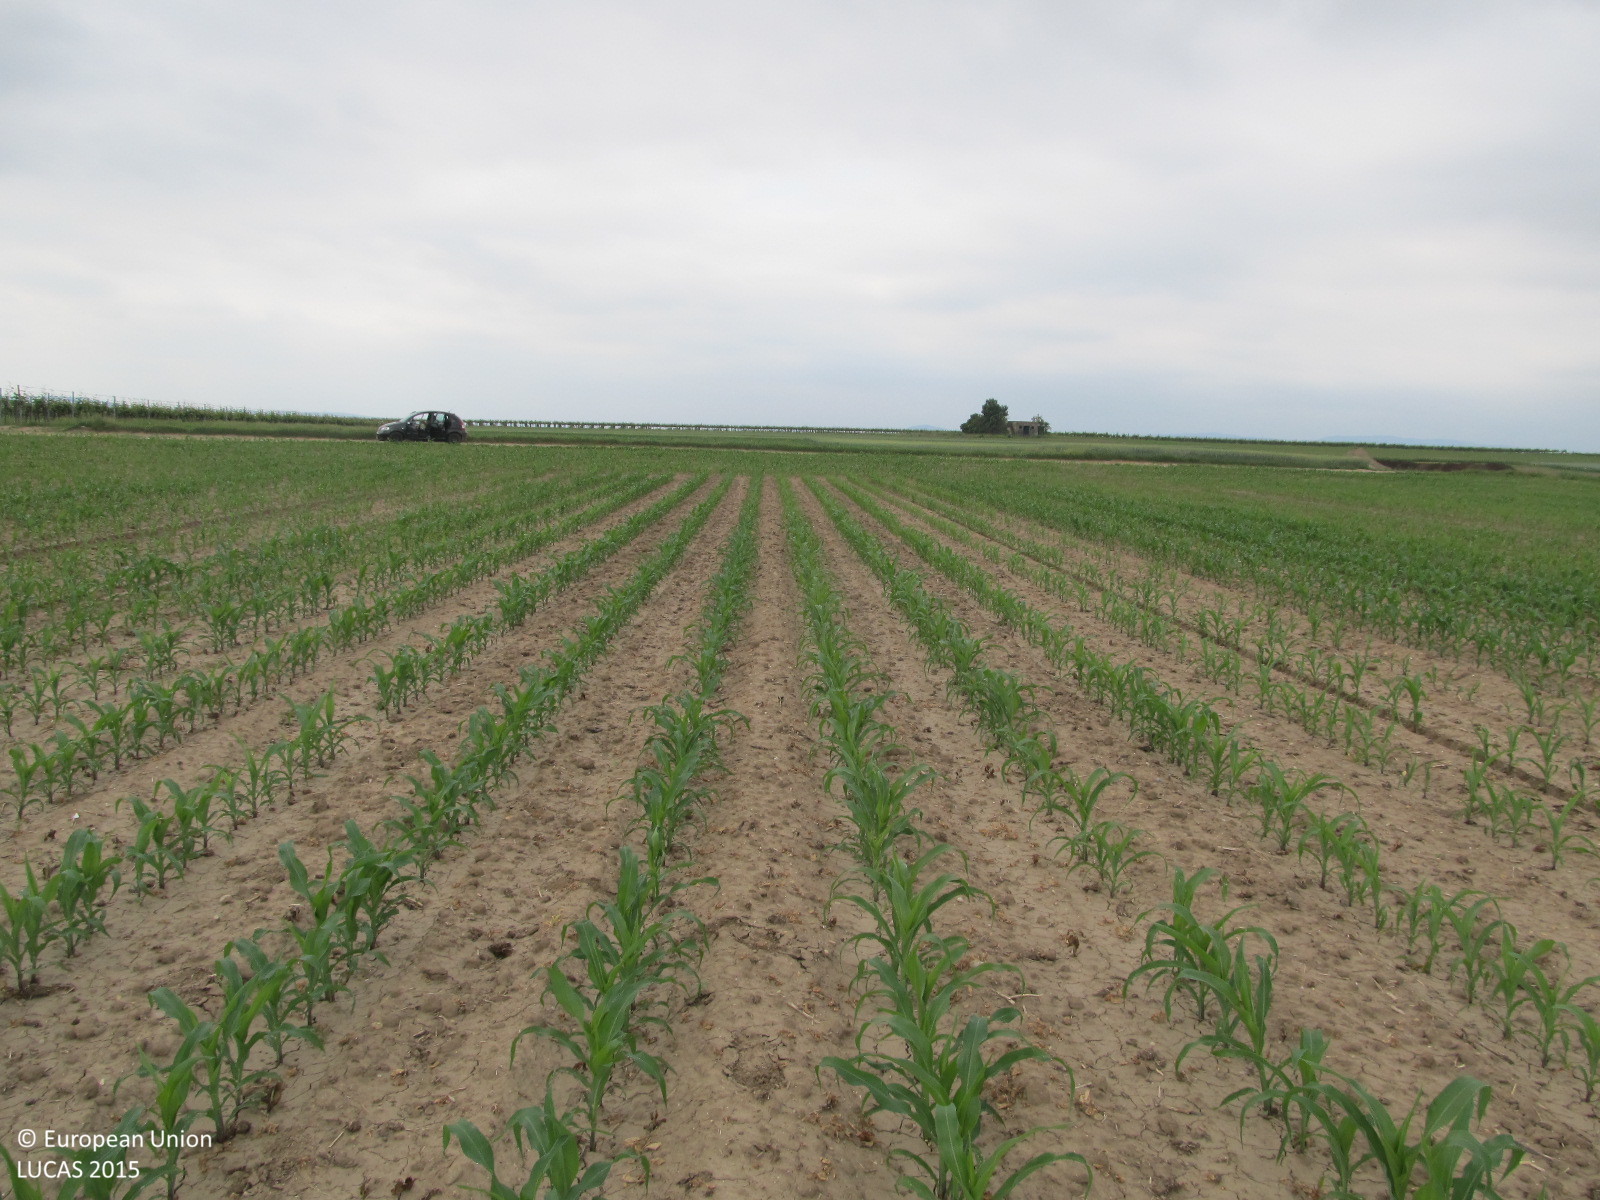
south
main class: Cropland
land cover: Maize
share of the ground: < 10 %
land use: Agriculture (excluding fallow land and kitchen gardens)
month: June
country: AT
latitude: 48.4399
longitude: 15.6400
